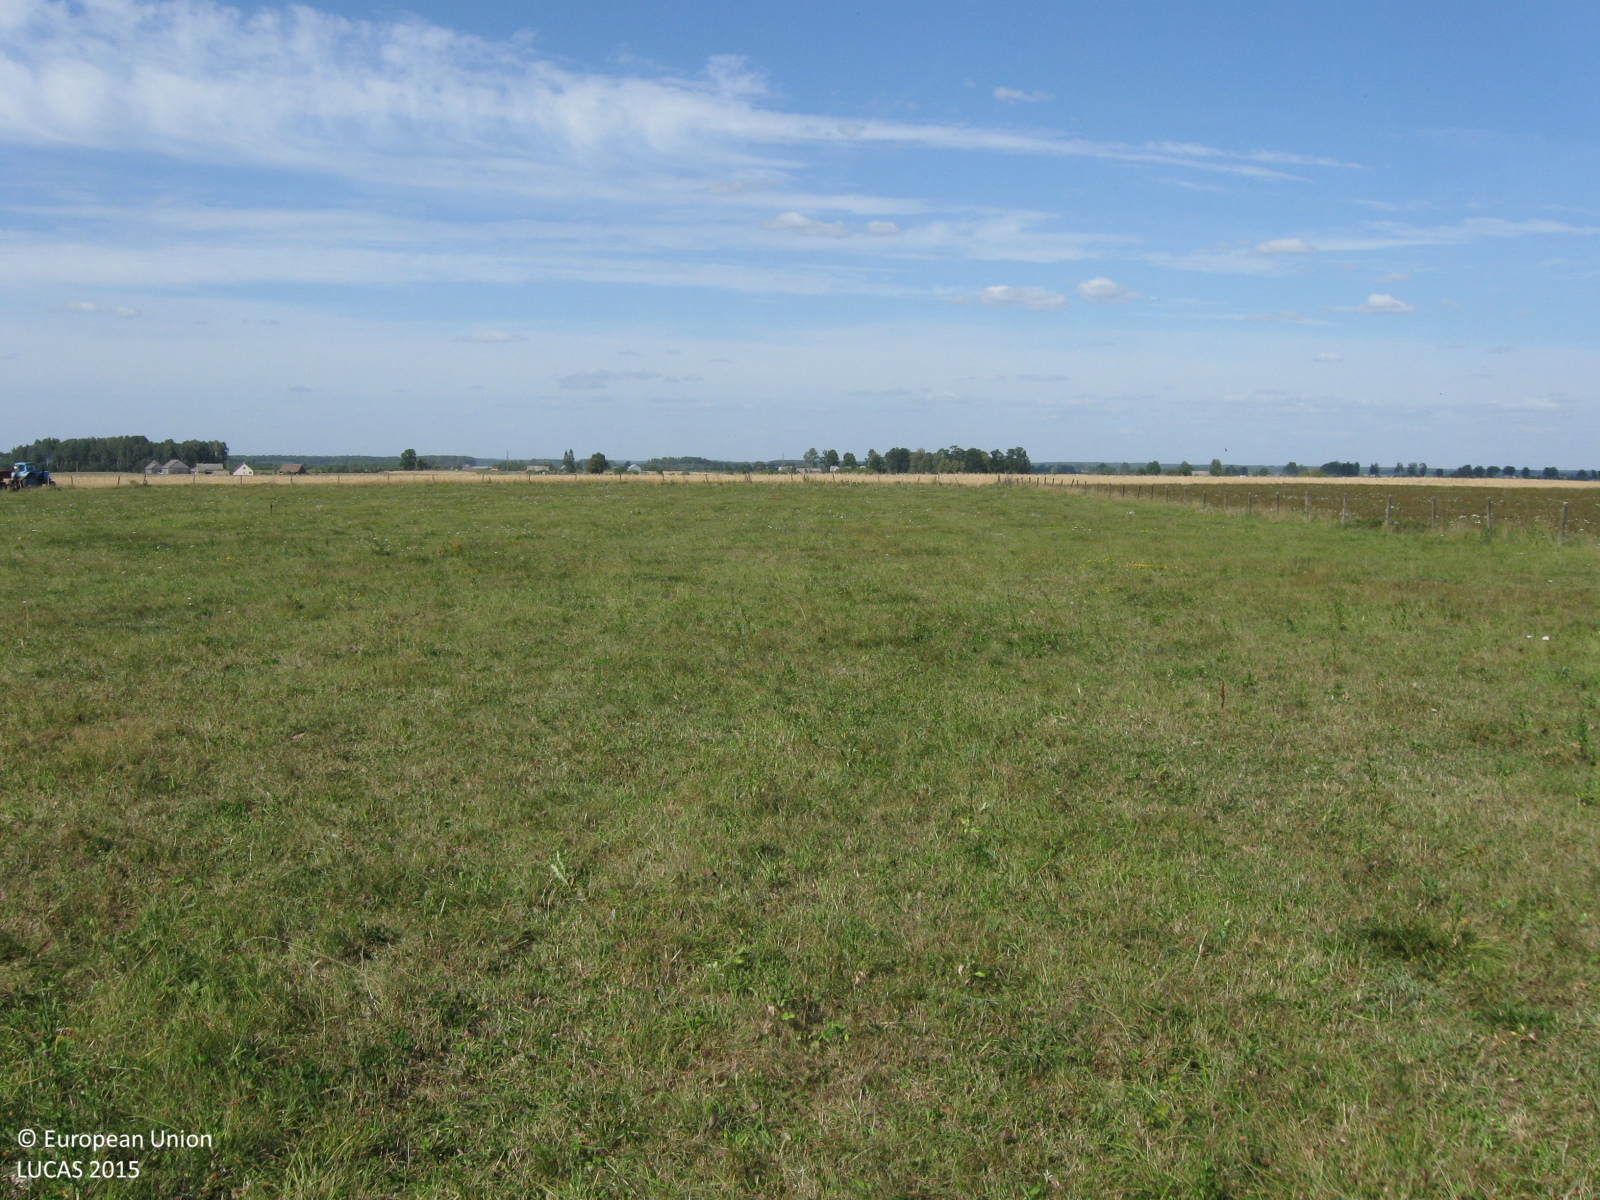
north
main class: Grassland
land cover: Grassland without tree/shrub cover
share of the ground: > 75 %
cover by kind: herbaceous plants 100 %
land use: Agriculture (excluding fallow land and kitchen gardens)
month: August
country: LT
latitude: 55.2276
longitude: 22.4981
